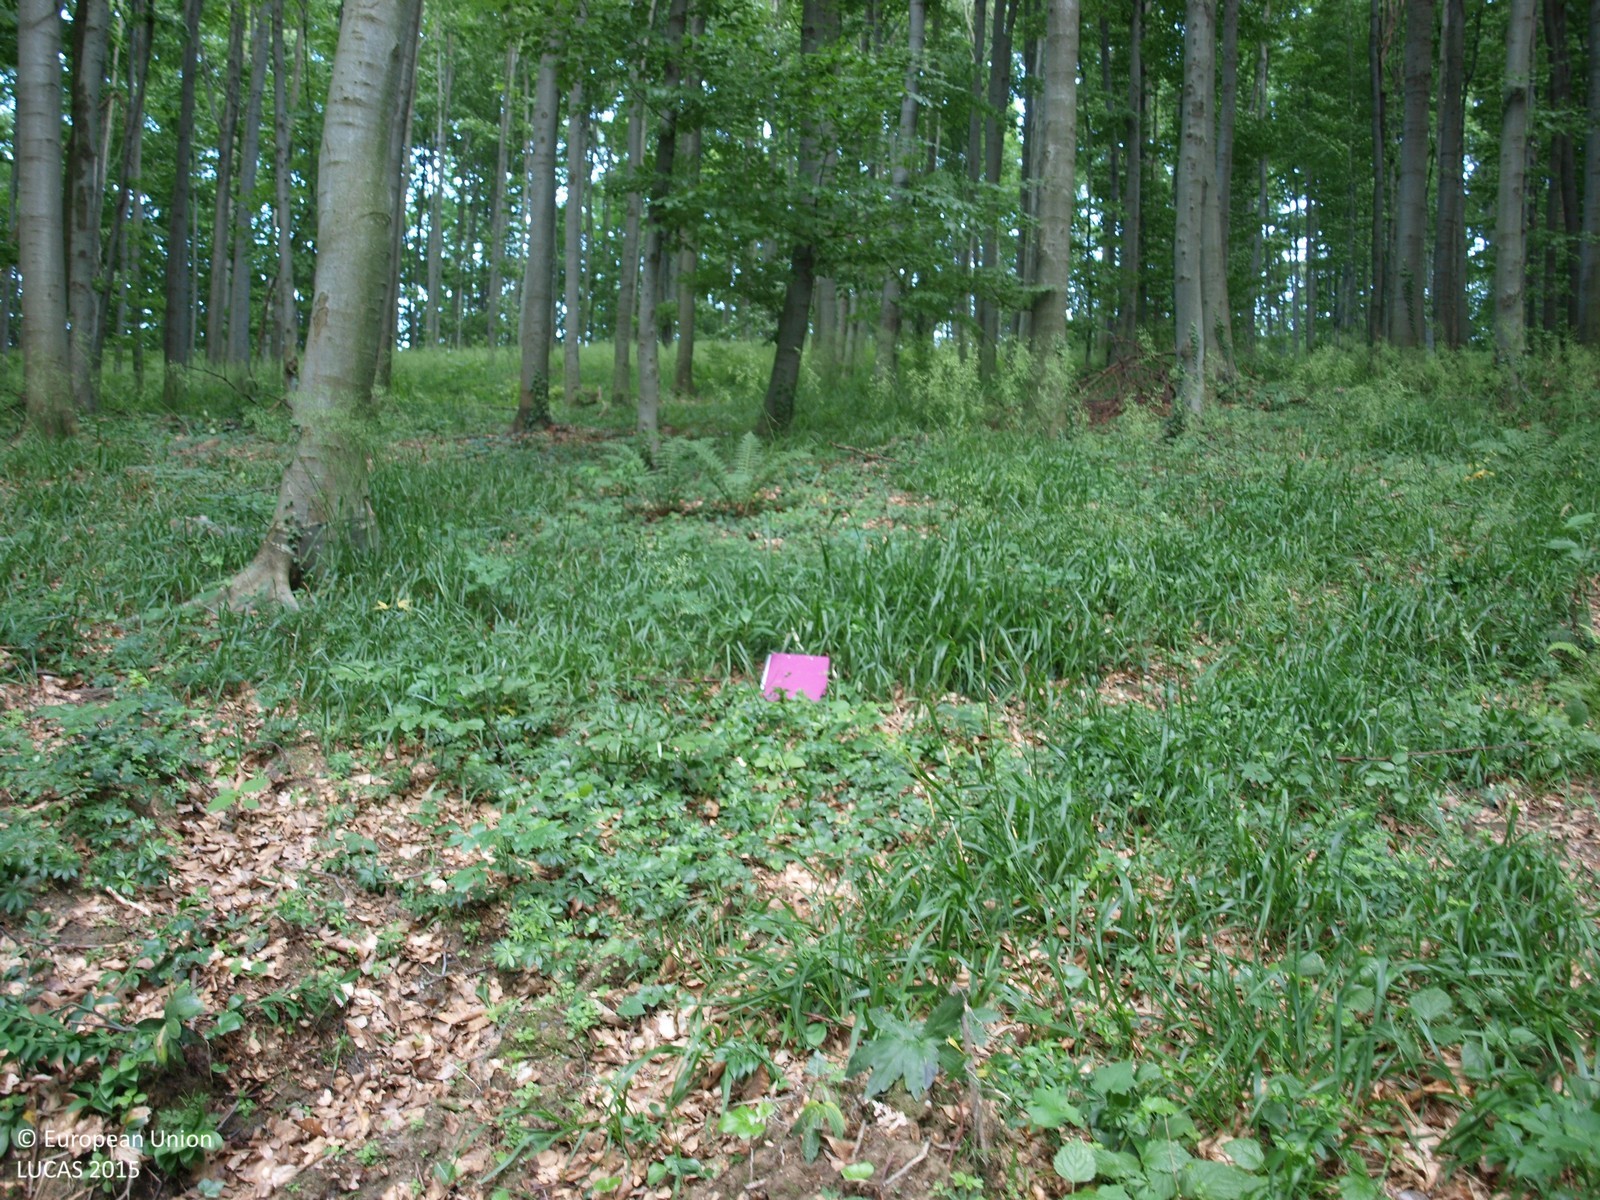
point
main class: Woodland
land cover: Broadleaved woodland
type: beech forest
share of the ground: > 75 %
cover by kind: broadleaved forest trees 100 %
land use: Forestry
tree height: > 5 m
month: June
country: HR
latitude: 46.1737
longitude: 16.4637
